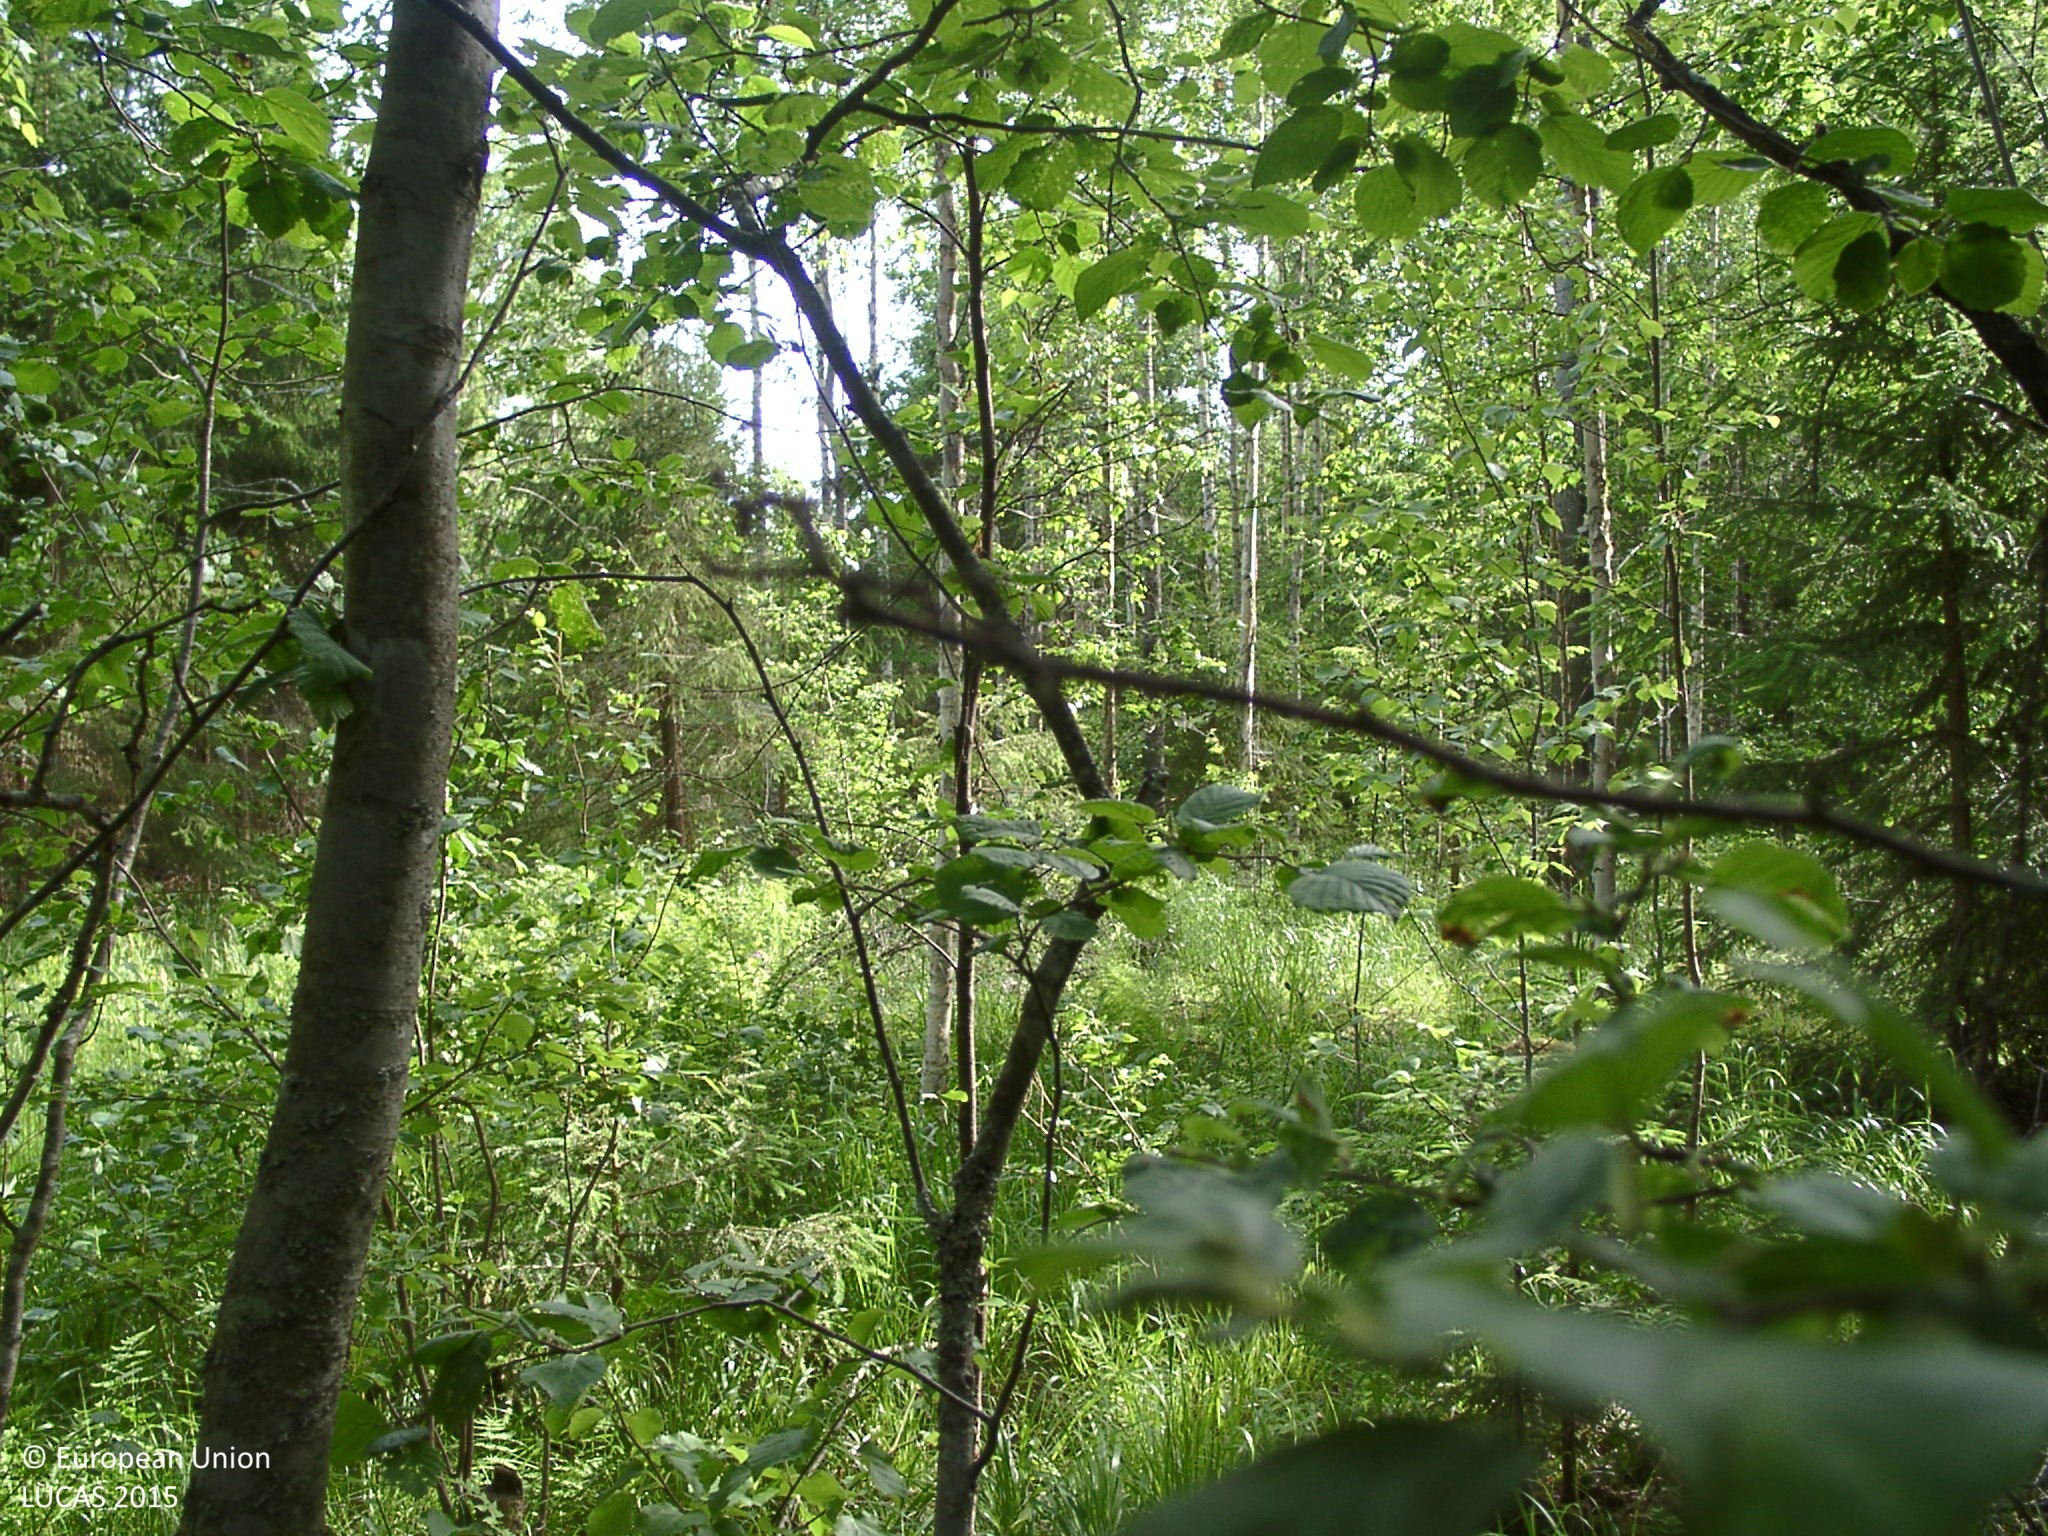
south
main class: Woodland
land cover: Broadleaved woodland
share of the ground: 50 - 75 %
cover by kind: broadleaved forest trees 60 %, herbaceous plants 25 %, coniferous forest trees 10 %, unconsolidated bare surface 5 %
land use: Semi-natural and natural areas not in use
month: June
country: FI
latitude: 62.0528
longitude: 25.0435
